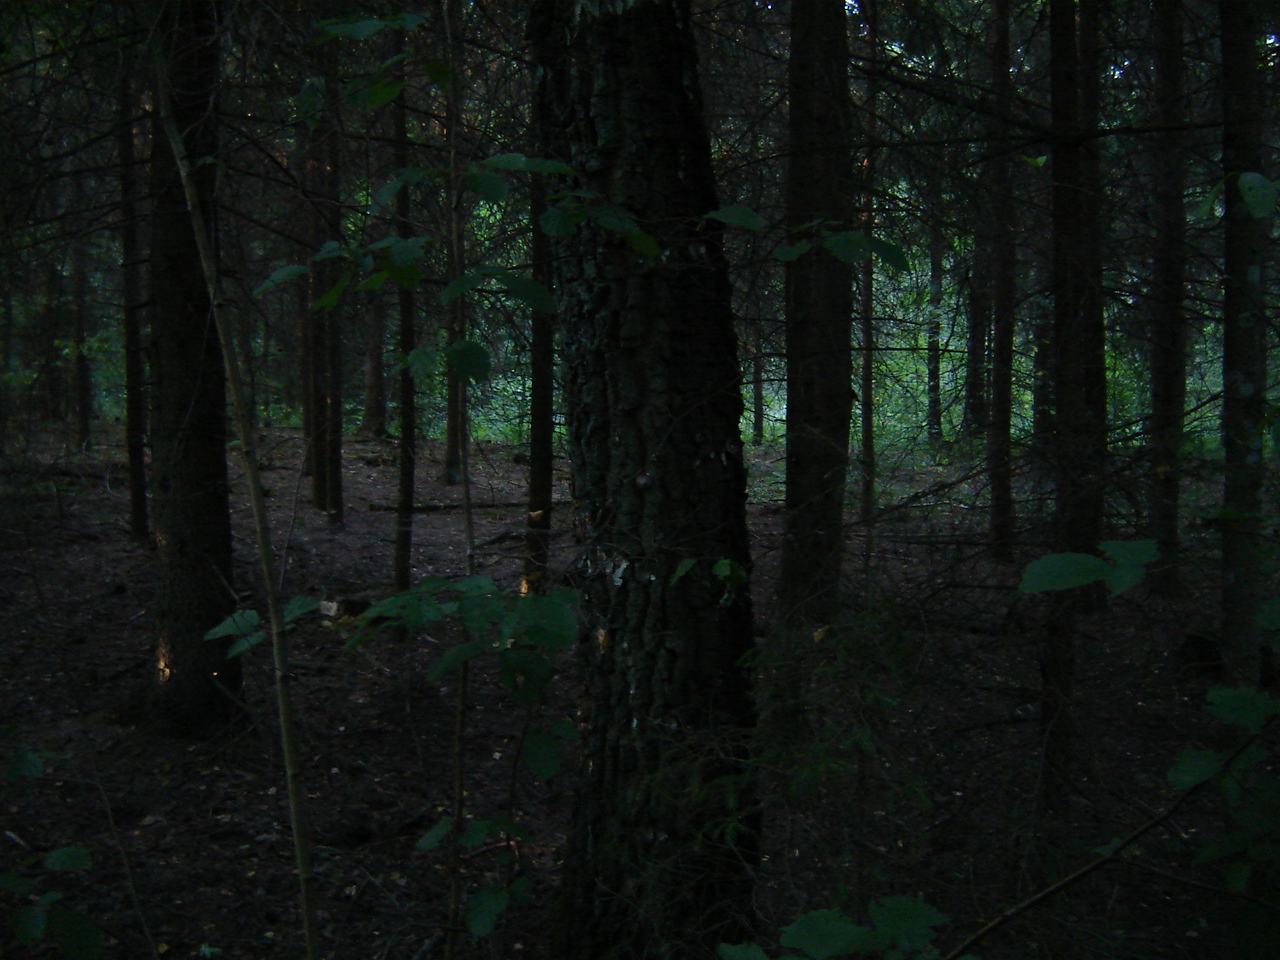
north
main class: Woodland
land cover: Spruce dominated mixed woodland
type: hemiboreal forest and nemoral coniferous forest and mixed broadleaved-coniferous forest
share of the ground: > 75 %
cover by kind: coniferous forest trees 65 %, broadleaved forest trees 30 %, unconsolidated bare surface 5 %
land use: Forestry
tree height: > 5 m
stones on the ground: < 10 %
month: August
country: LT
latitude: 54.8038
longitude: 25.0022
